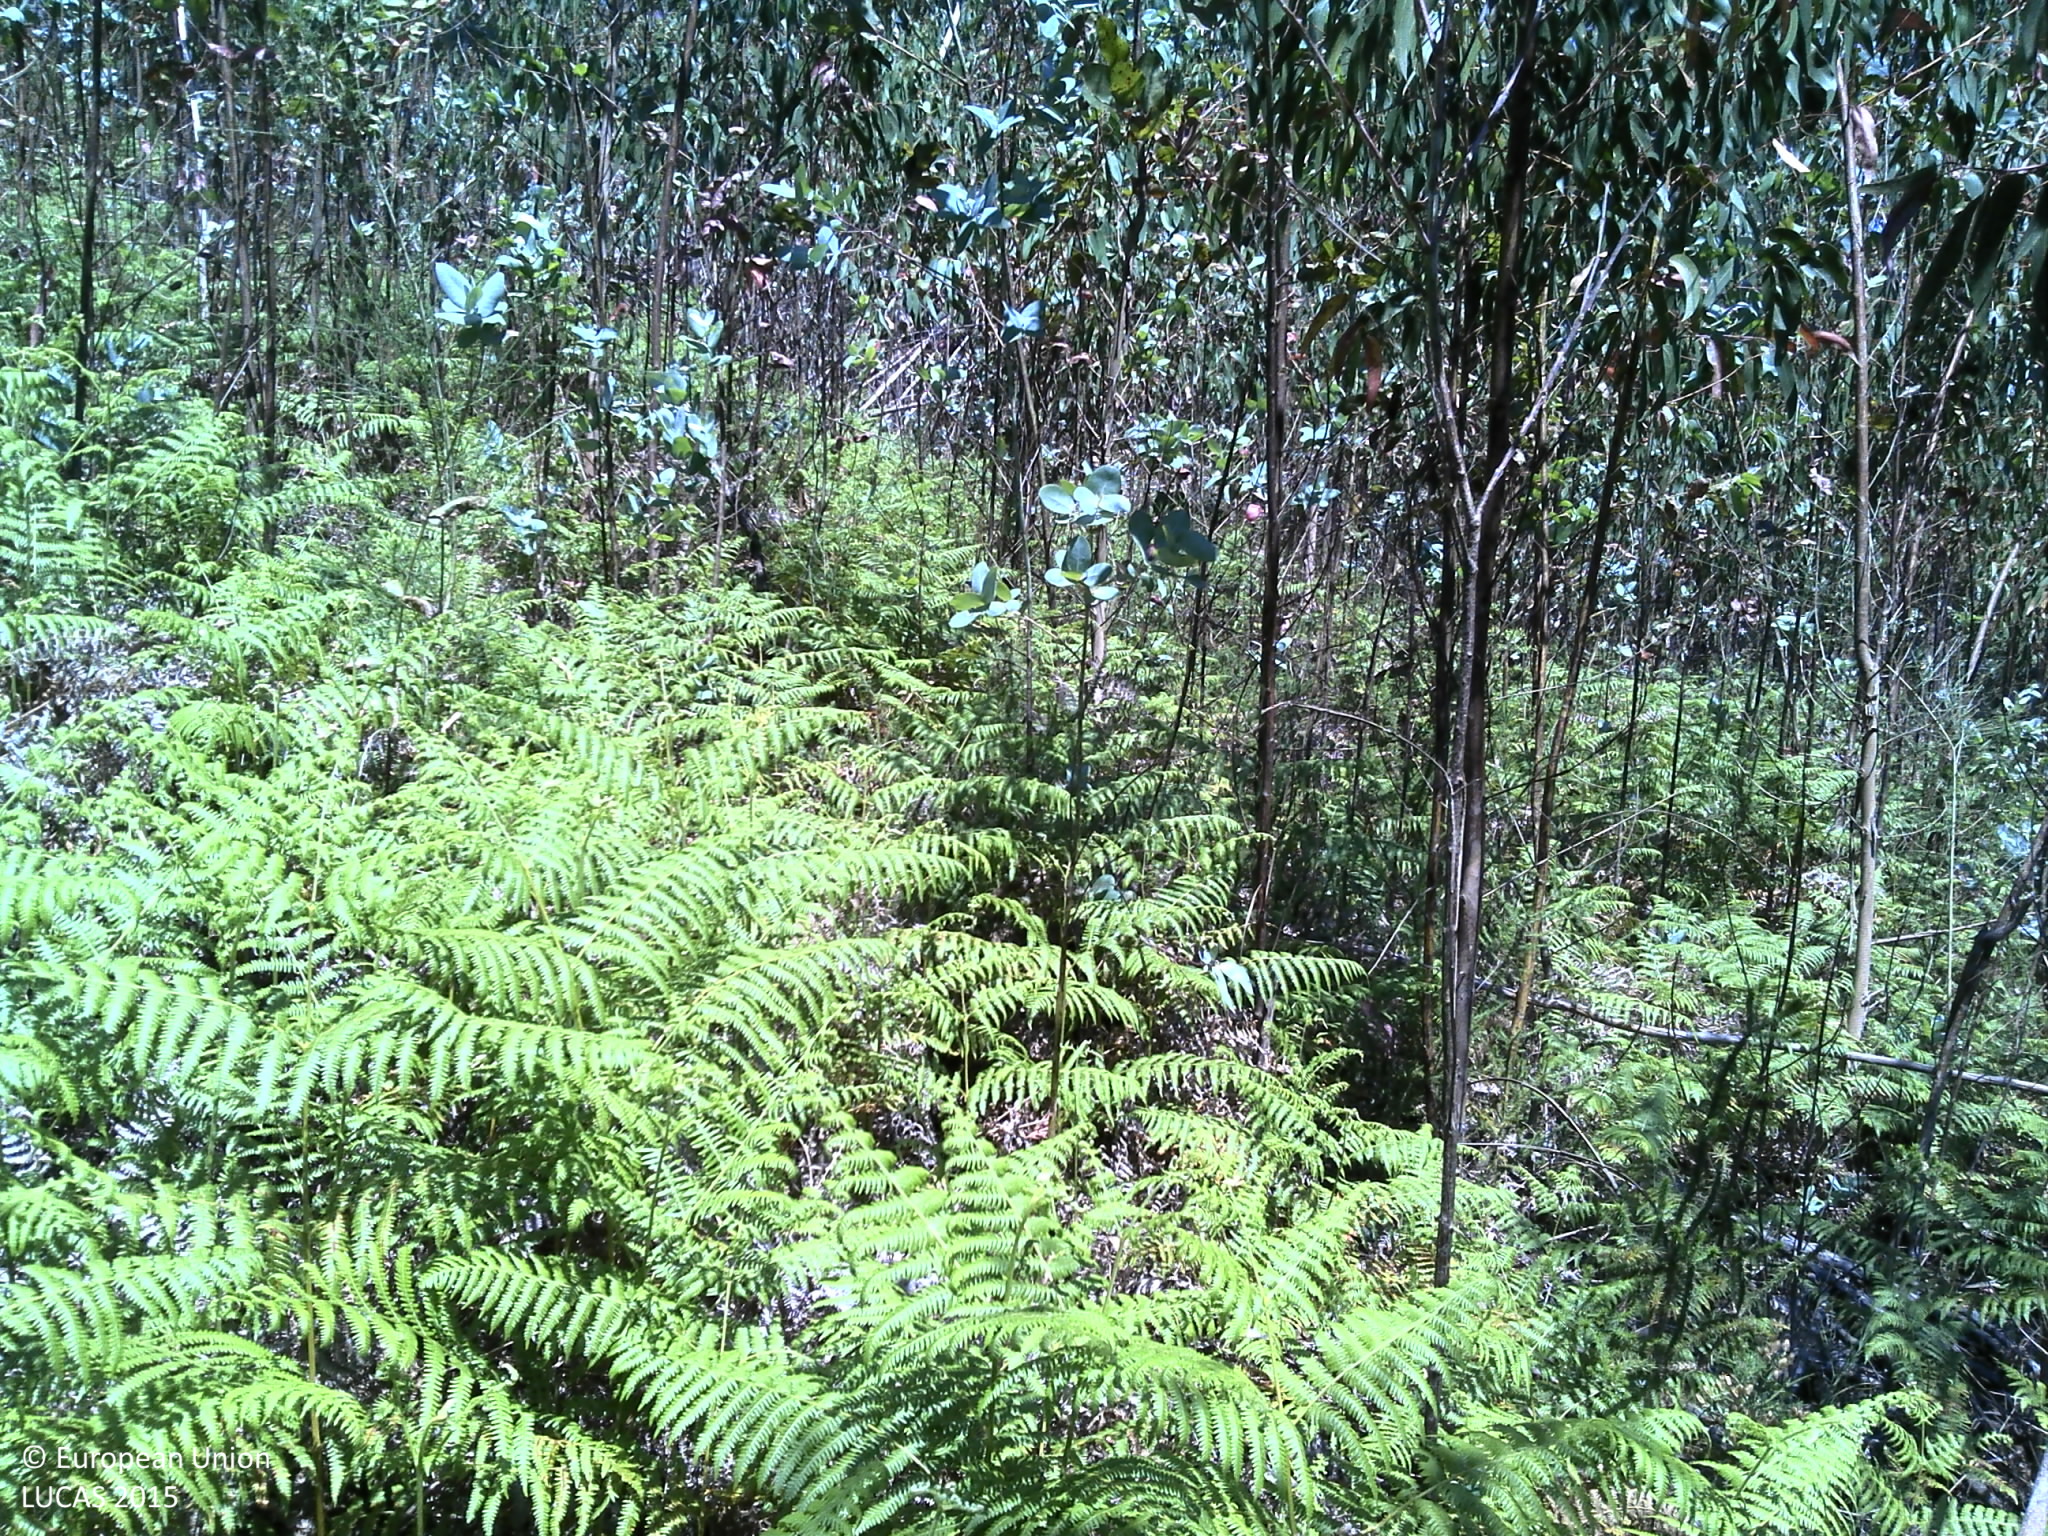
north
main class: Woodland
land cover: Broadleaved woodland
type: exotic forest
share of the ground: 25 - 50 %
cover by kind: broadleaved forest trees 50 %, shrubs 35 %, unconsolidated bare surface 10 %, herbaceous plants 5 %
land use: Forestry
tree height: > 5 m
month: May
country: PT
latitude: 41.6843
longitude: -8.6270
